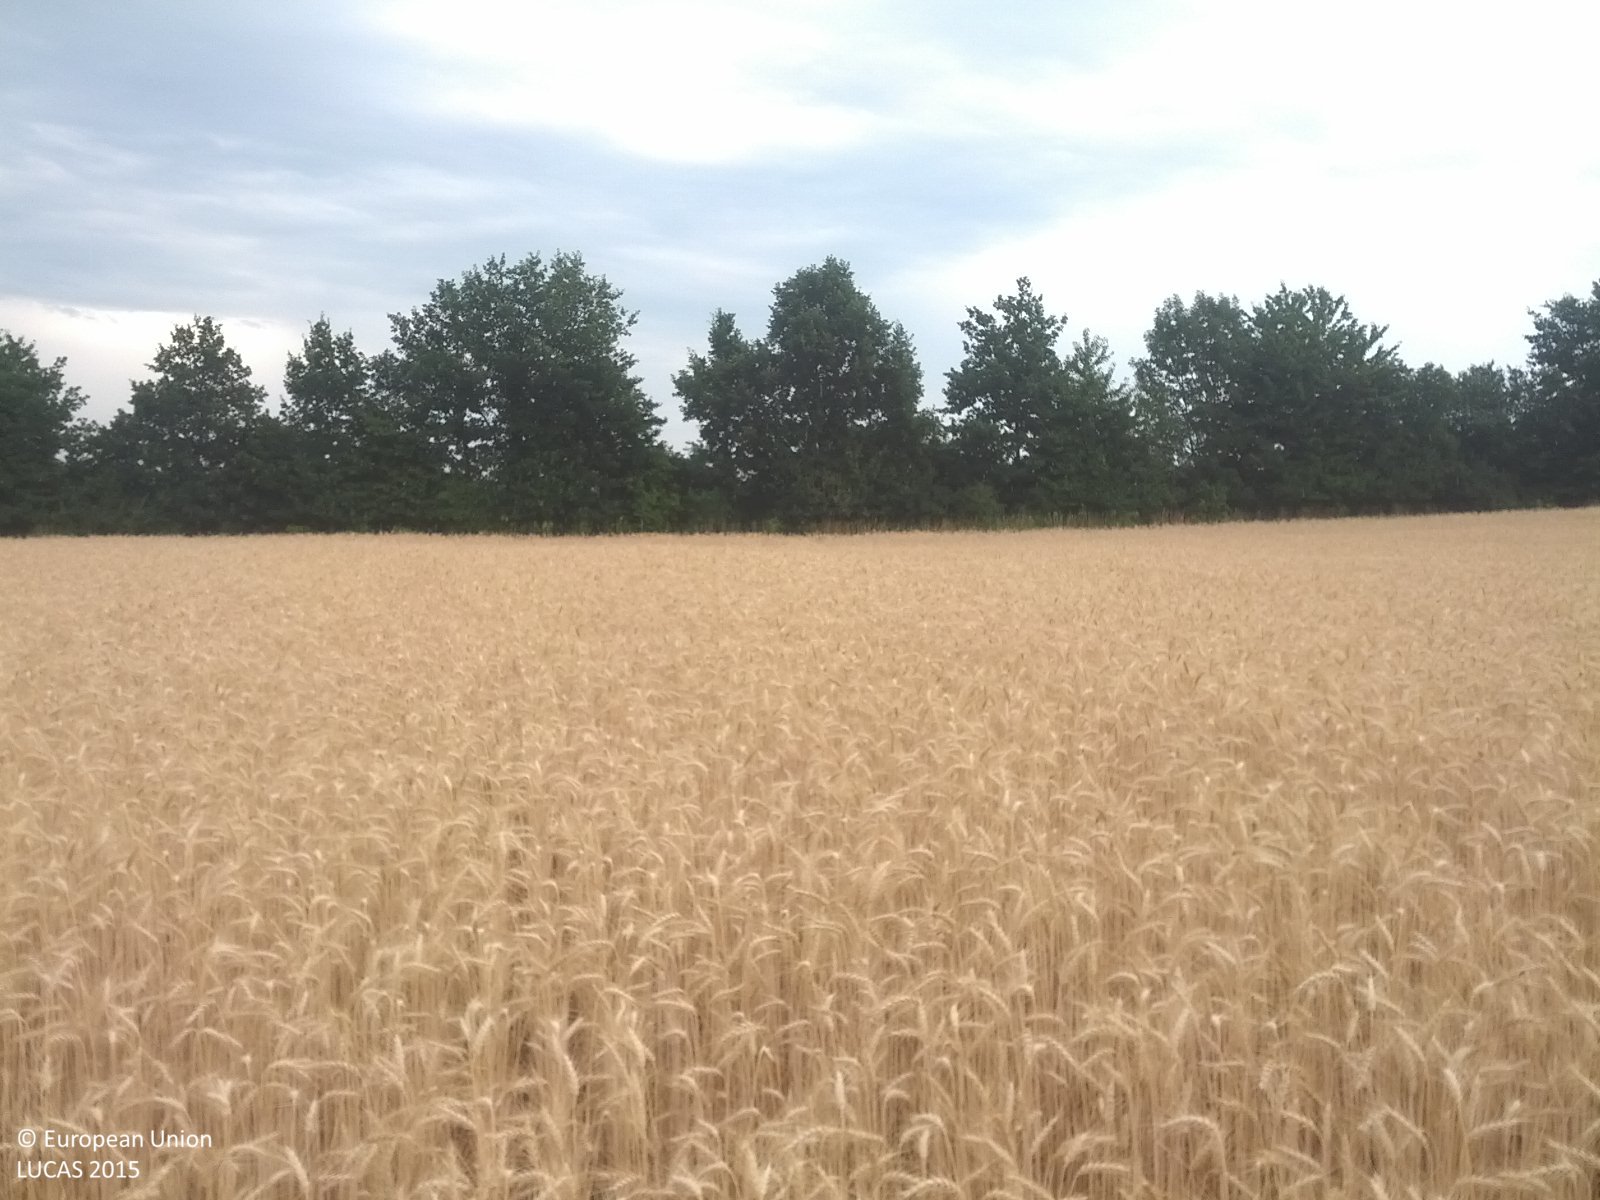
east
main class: Cropland
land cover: Common wheat
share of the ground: > 75 %
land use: Agriculture (excluding fallow land and kitchen gardens)
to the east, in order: Common wheat; Grass margins; Tracks; Grass margins; Broadleaved woodland; Grass margins; Tracks; Maize
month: July
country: AT
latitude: 48.7818
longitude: 16.6348
